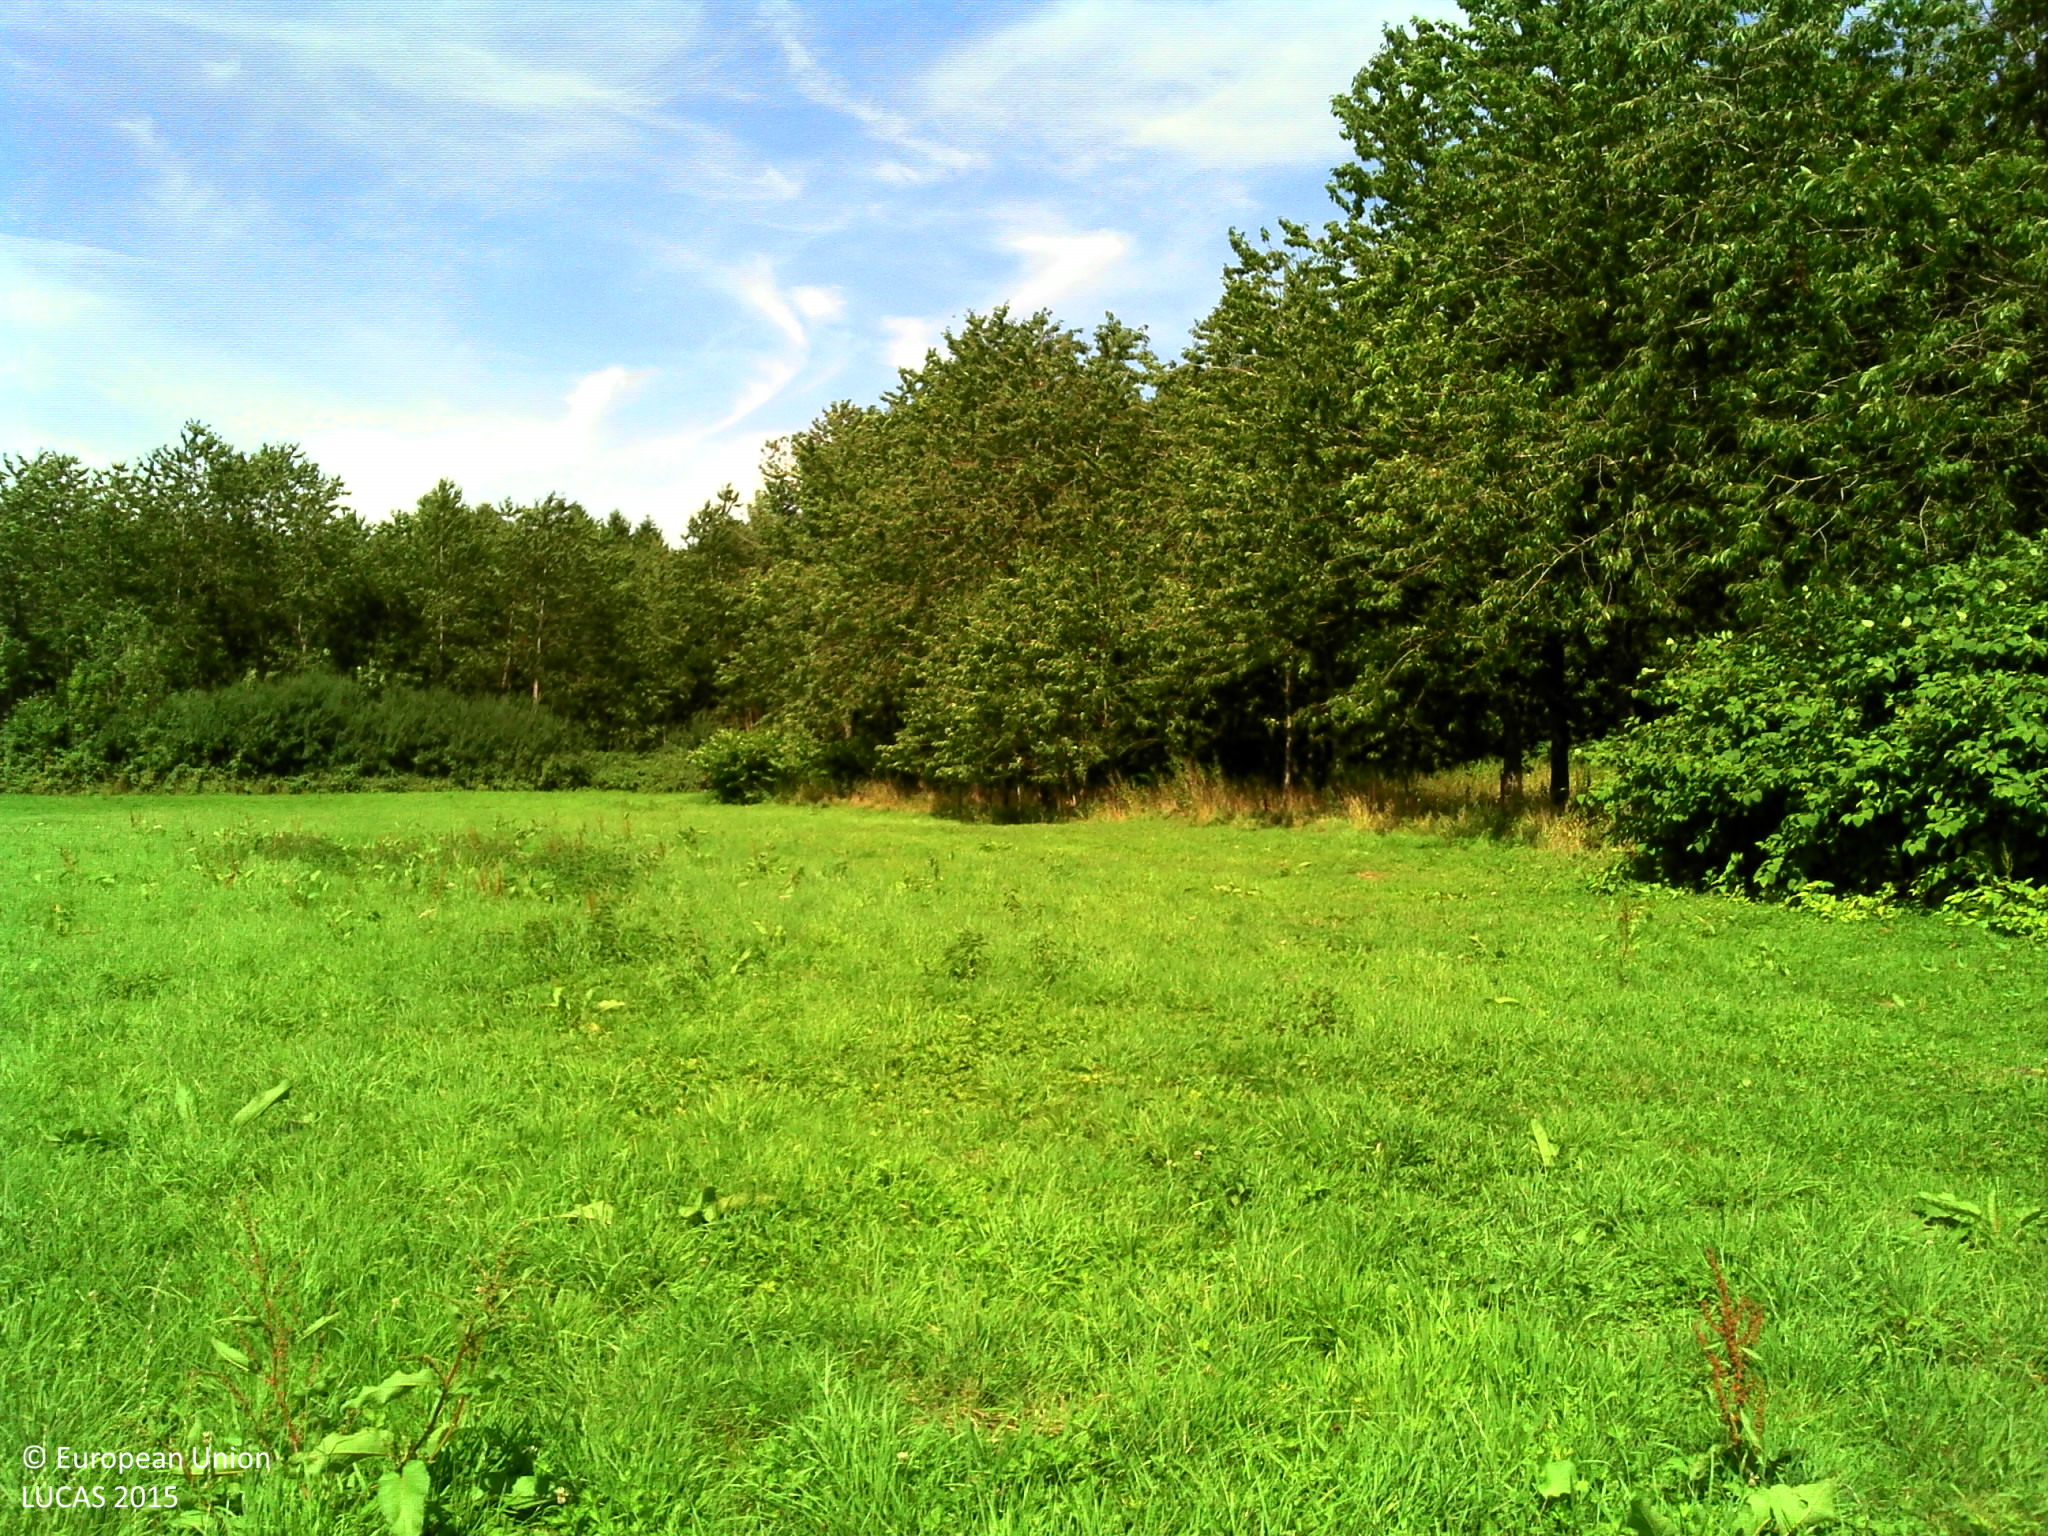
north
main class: Grassland
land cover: Grassland without tree/shrub cover
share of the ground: > 75 %
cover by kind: herbaceous plants 100 %
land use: Agriculture (excluding fallow land and kitchen gardens)
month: August
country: FR
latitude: 50.0503
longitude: 4.1152
